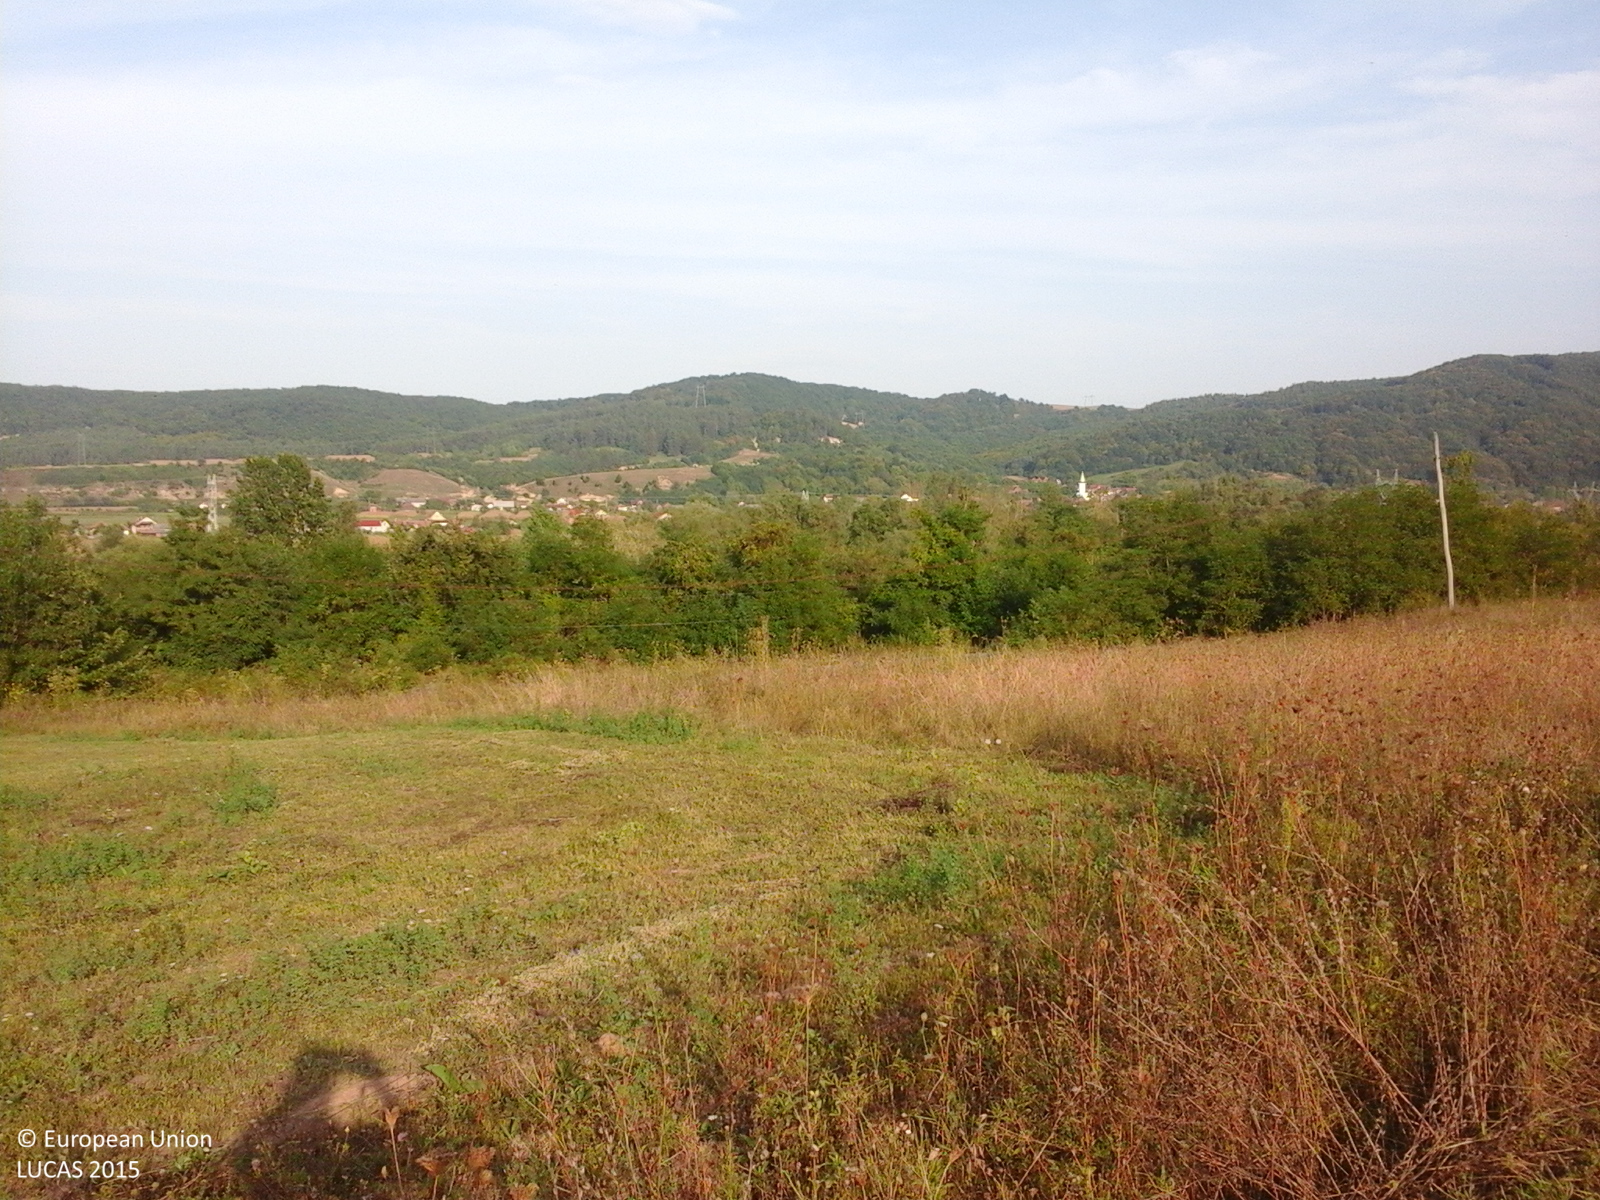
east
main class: Cropland
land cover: Other fruit trees and berries
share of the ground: > 75 %
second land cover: Grassland without tree/shrub cover
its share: > 75 %
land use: Agriculture (excluding fallow land and kitchen gardens)
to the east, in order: Other fruit trees and berries; Grassland without tree/shrub cover; Lucerne; Grassland without tree/shrub cover; Grass margins; Paved roads, cycling and walking lanes; Grass margins; Shrubland with sparse tree cover; Broadleaved woodland; Inland salty running water; Rocks and stones
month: September
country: RO
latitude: 47.2289
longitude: 23.3161
